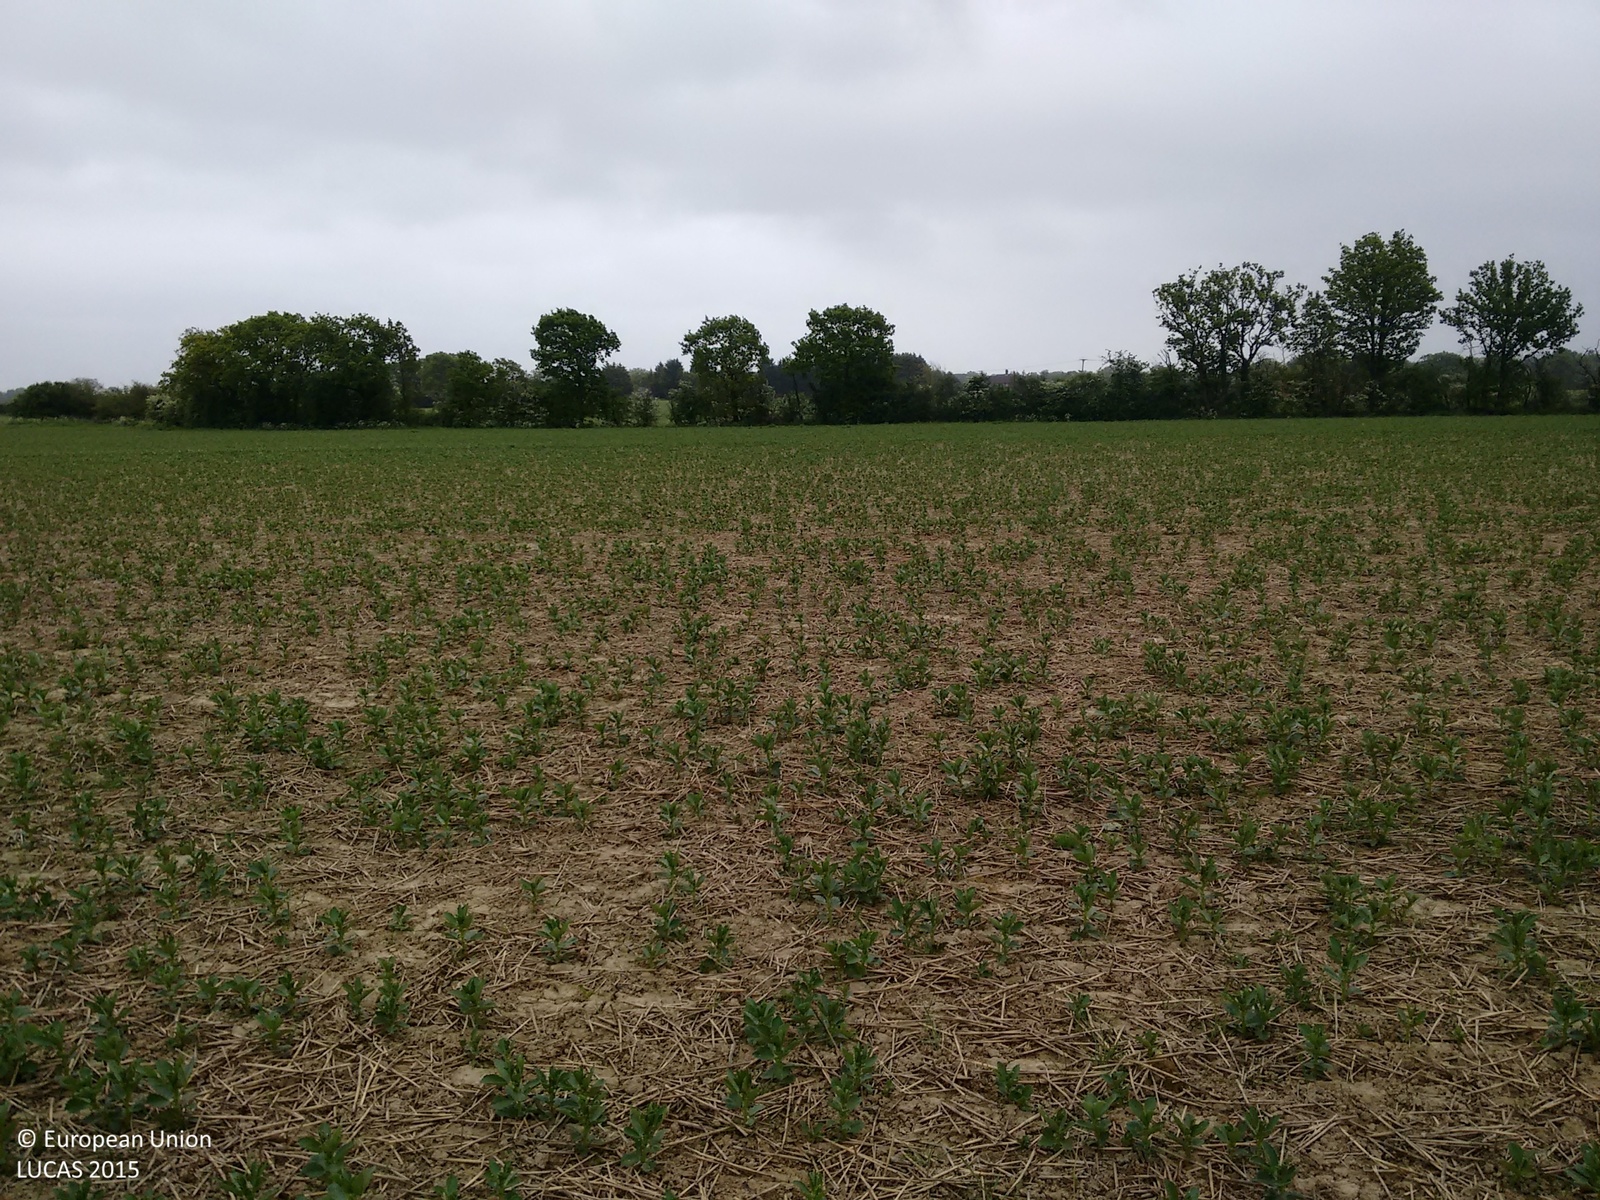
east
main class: Cropland
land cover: Dry pulses
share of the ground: 10 - 25 %
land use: Agriculture (excluding fallow land and kitchen gardens)
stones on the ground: < 10 %
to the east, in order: Dry pulses; Grassland without tree/shrub cover; Rivers and streams; Managed hedges; Dry pulses; Grassland without tree/shrub cover; Rivers and streams; Shruby margins; Common wheat
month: May
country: GB
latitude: 51.1467
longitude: 0.5234
